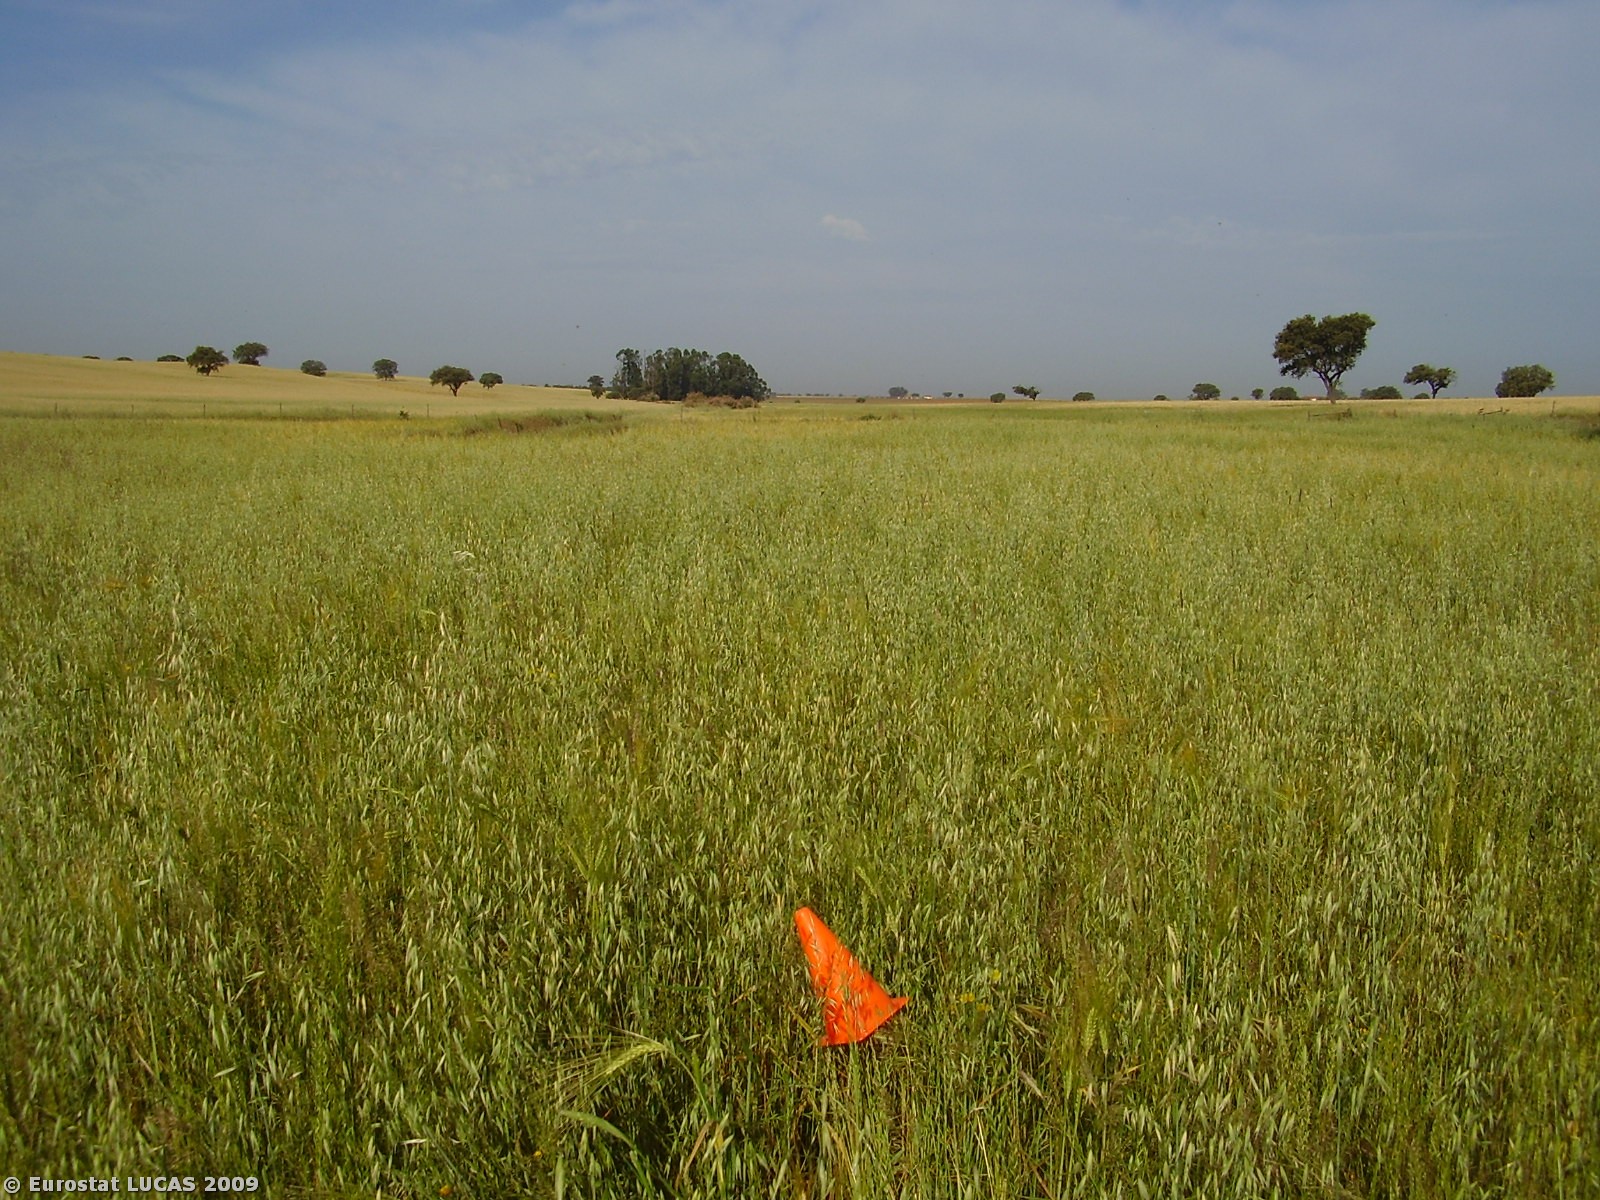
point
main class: Cropland
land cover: Mixed cereals for fodder
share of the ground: > 75 %
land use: Agriculture (excluding fallow land and kitchen gardens)
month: May
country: PT
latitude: 37.9531
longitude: -7.9299
